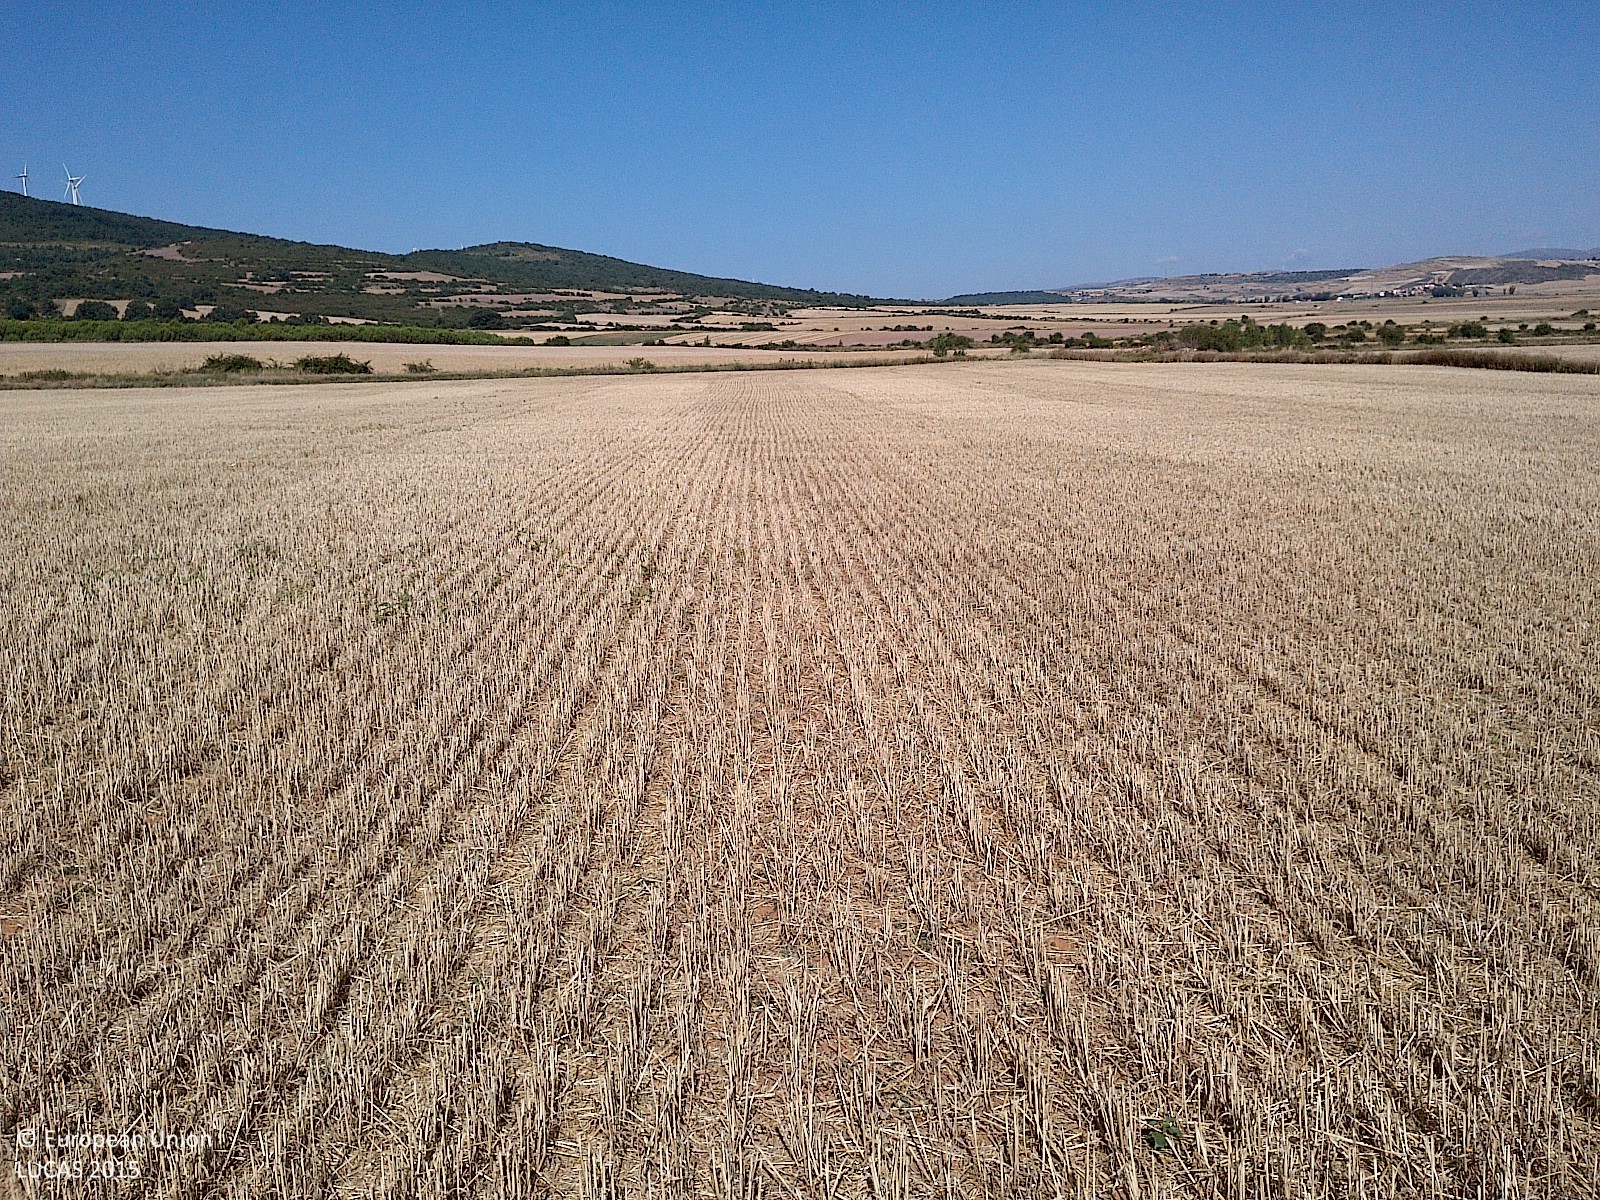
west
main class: Cropland
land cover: Common wheat
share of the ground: < 10 %
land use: Agriculture (excluding fallow land and kitchen gardens)
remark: Harvested field
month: July
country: ES
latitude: 41.8566
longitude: -2.0683
